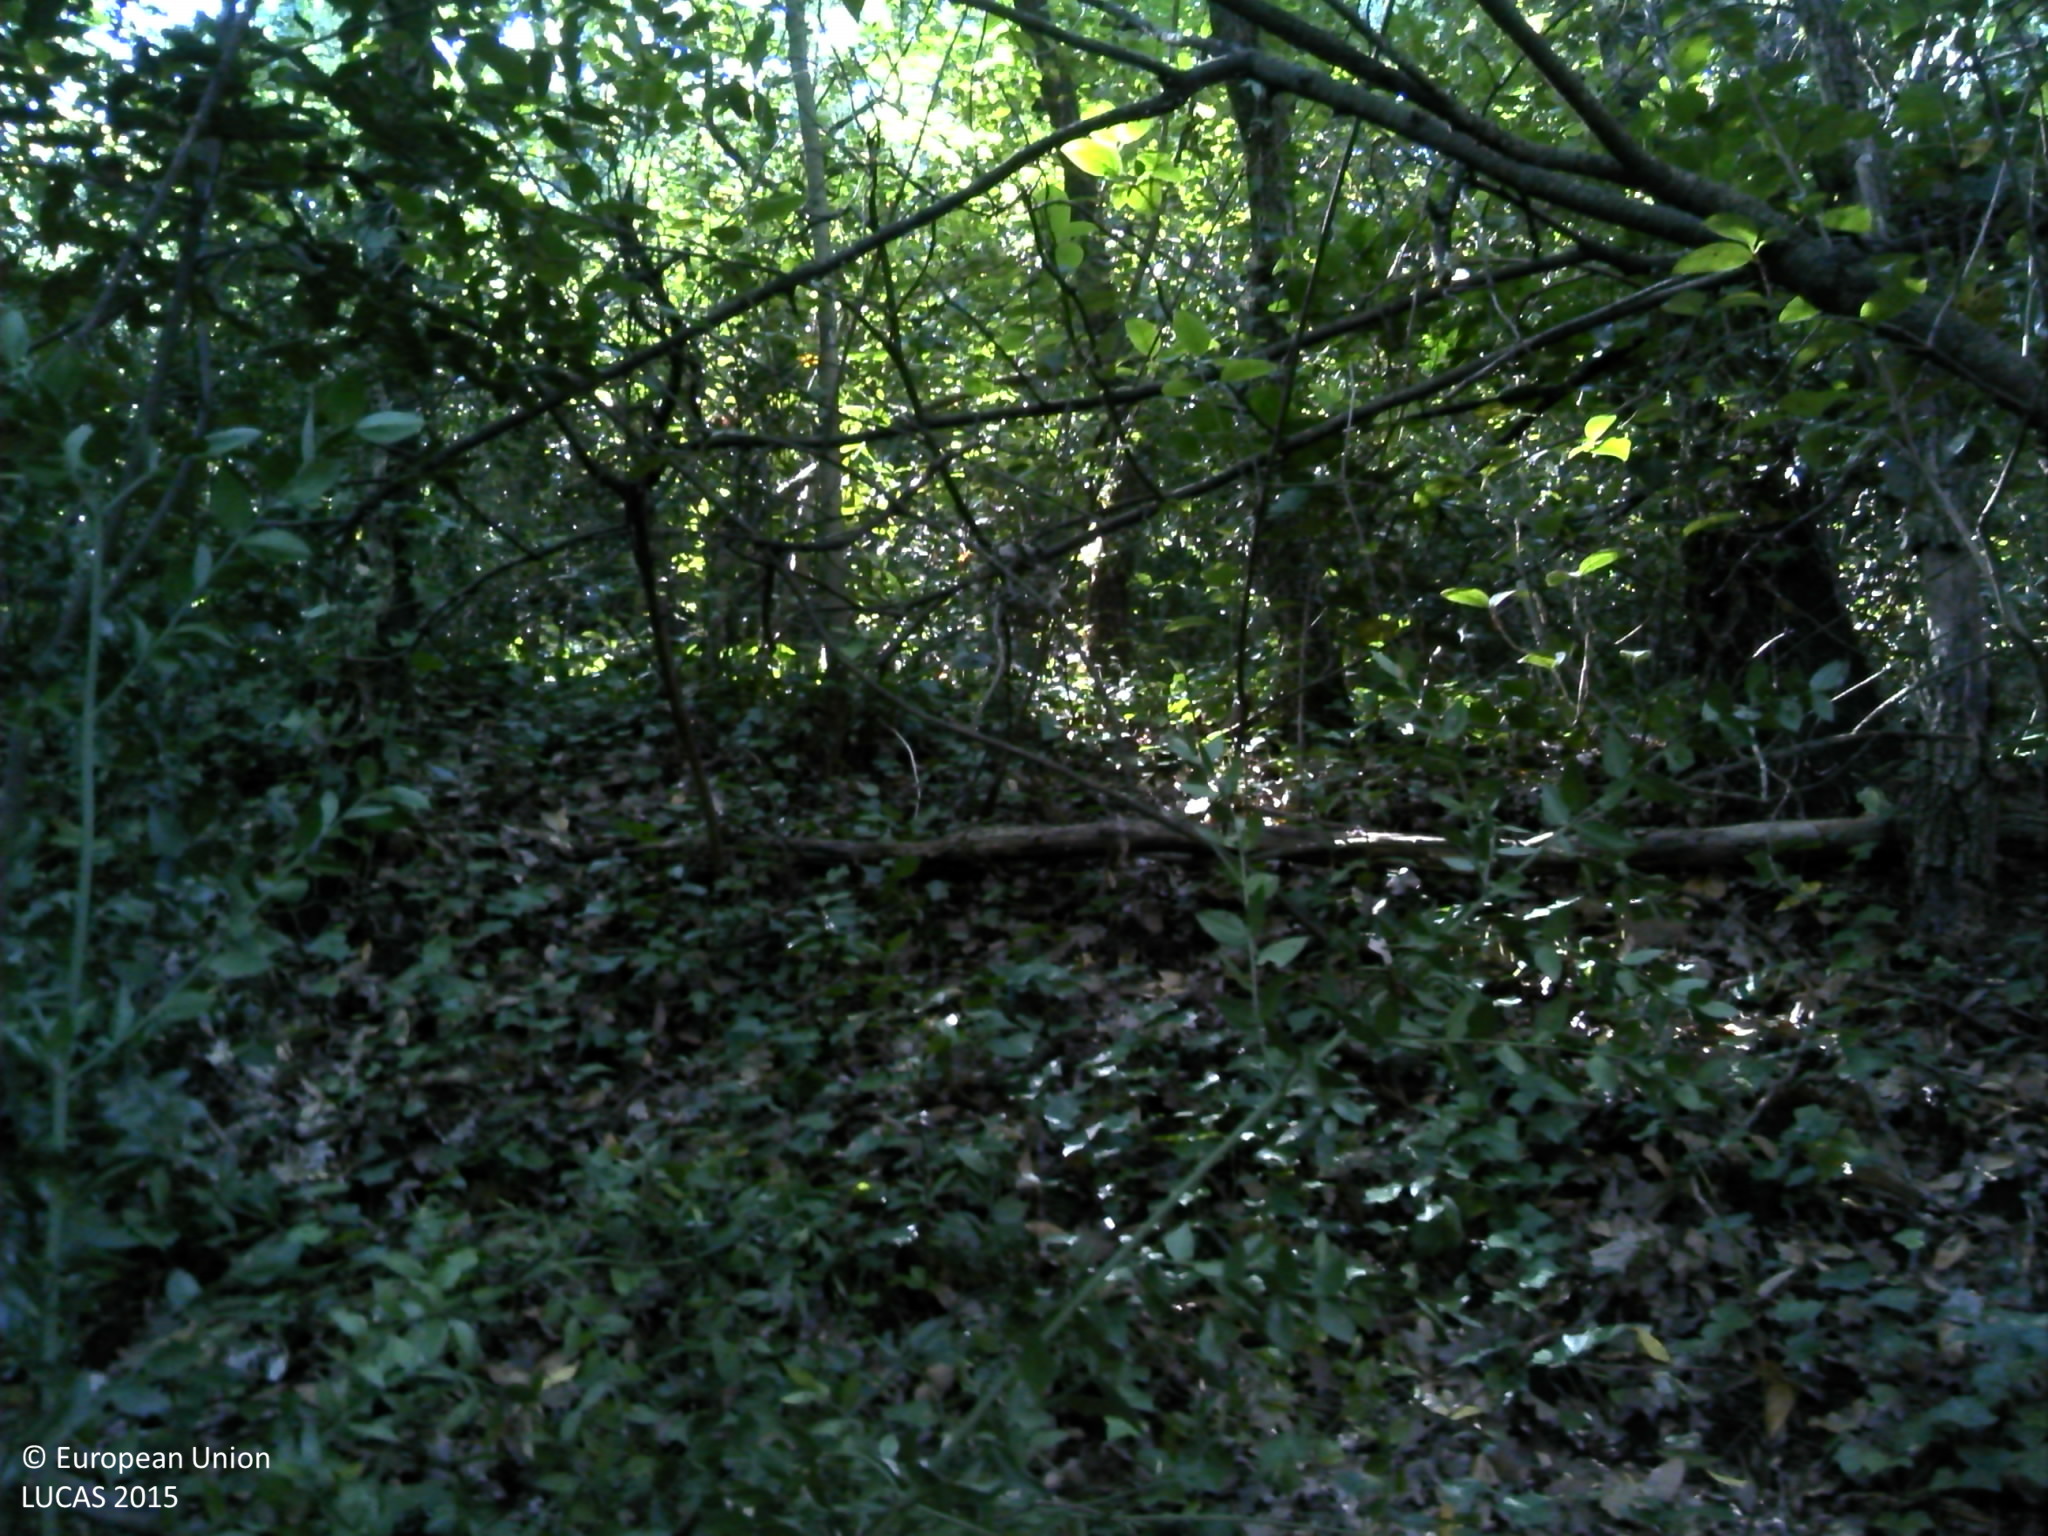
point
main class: Woodland
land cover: Broadleaved woodland
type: broadleaved evergreen forest
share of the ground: > 75 %
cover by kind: broadleaved forest trees 80 %, herbaceous plants 10 %, unconsolidated bare surface 10 %
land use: Semi-natural and natural areas not in use
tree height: > 5 m
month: October
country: FR
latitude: 43.7644
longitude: 4.3819
